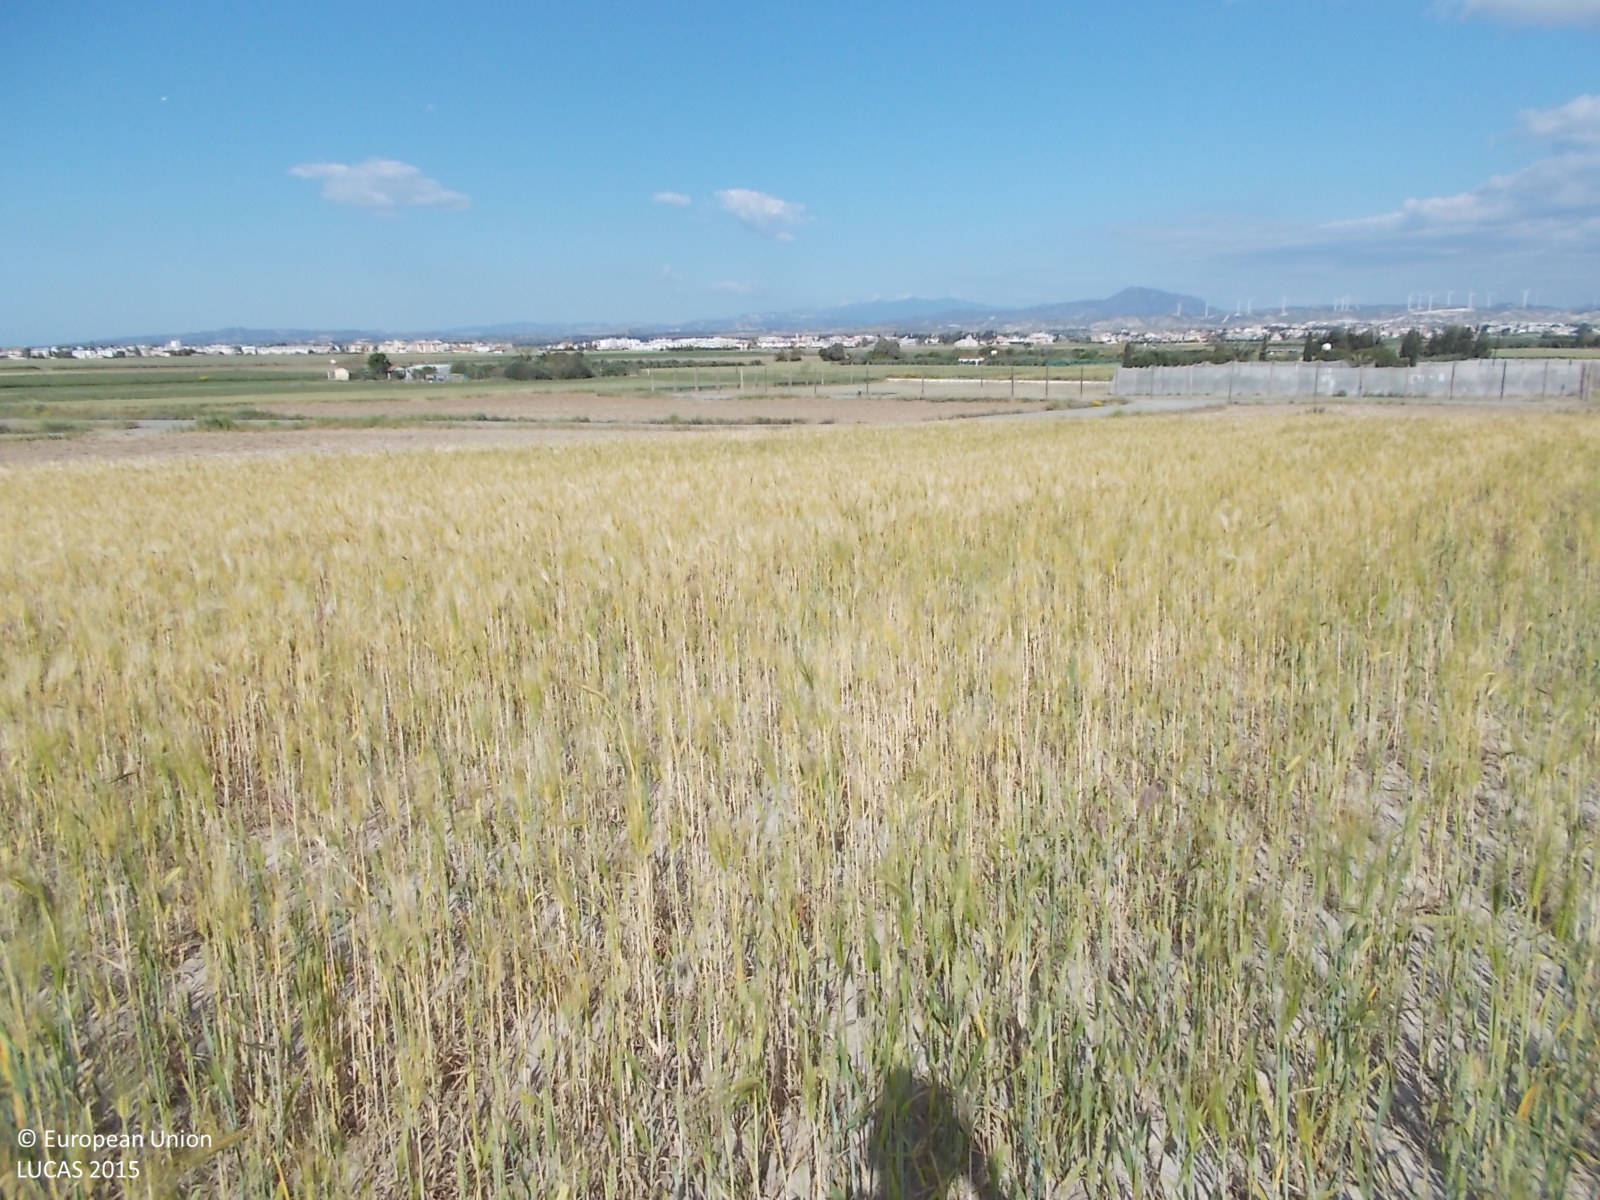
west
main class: Cropland
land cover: Barley
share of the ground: > 75 %
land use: Agriculture (excluding fallow land and kitchen gardens)
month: April
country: CY
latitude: 34.8259
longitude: 33.6010
